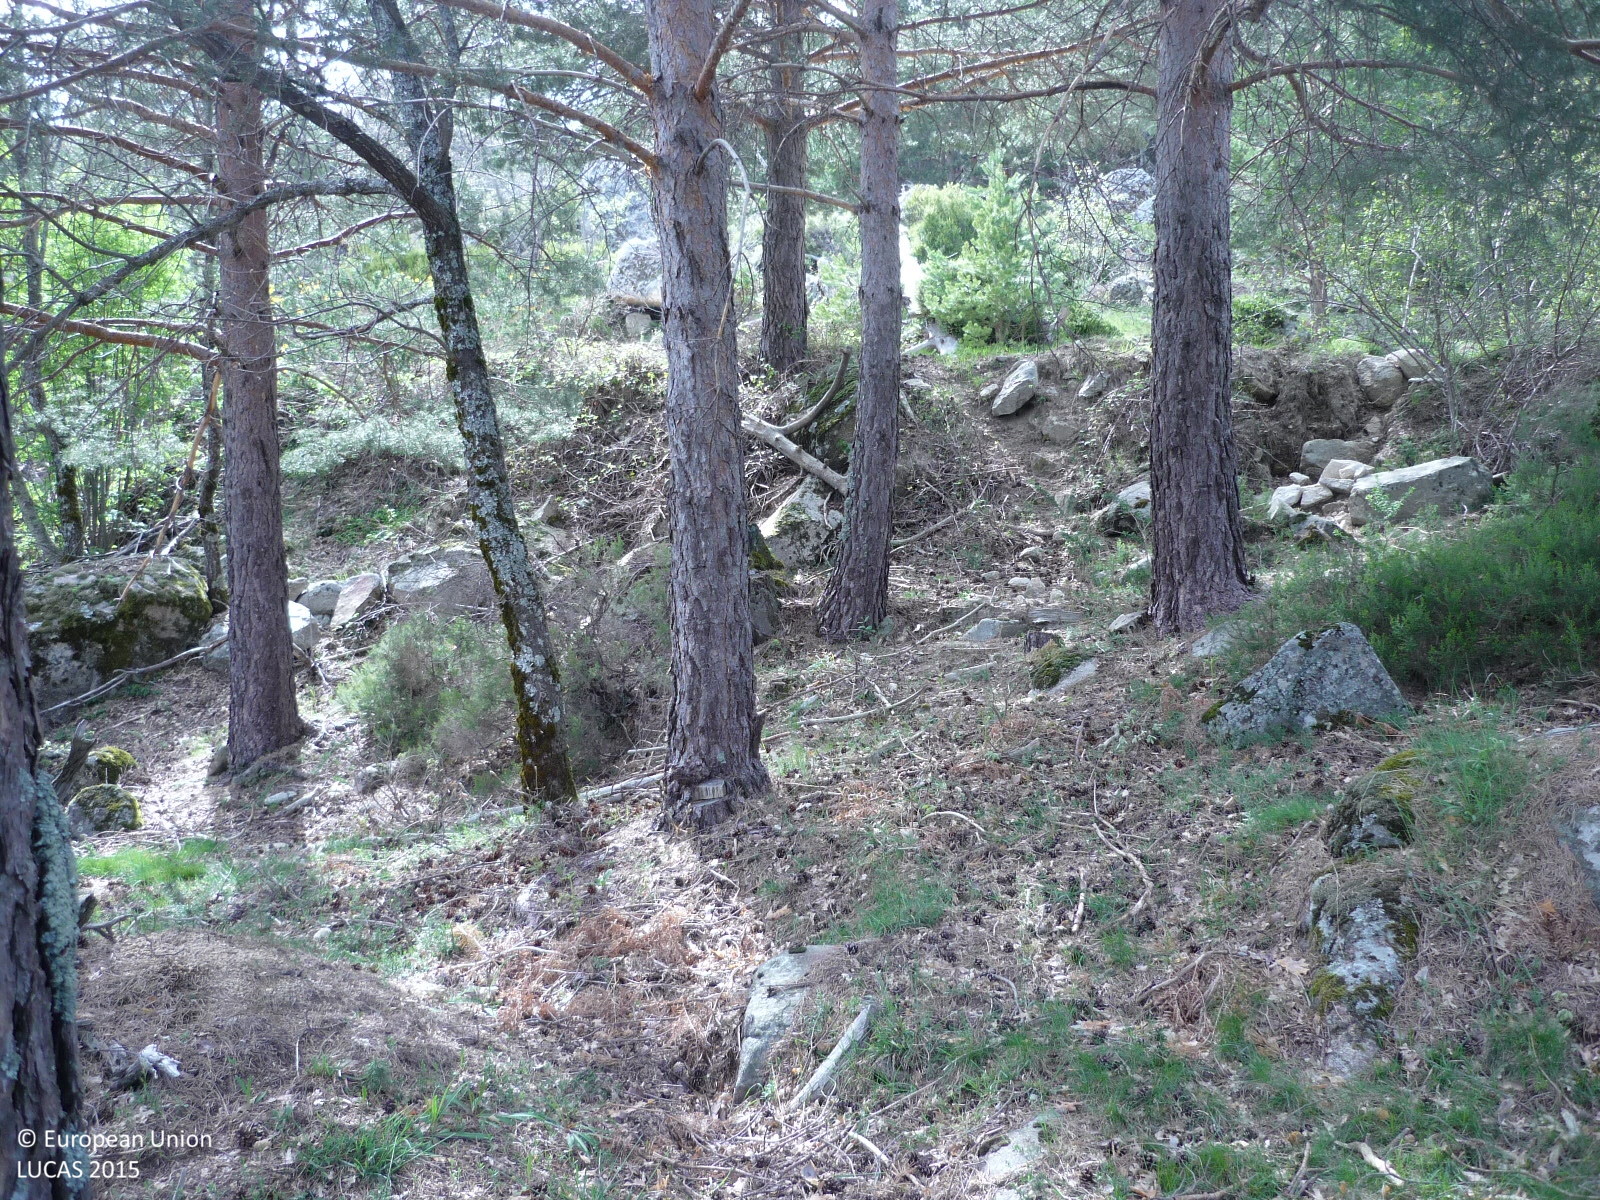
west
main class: Woodland
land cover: Pine dominated coniferous woodland
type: coniferous forest of the mediterranean region
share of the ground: > 75 %
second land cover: Grassland without tree/shrub cover
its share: 25 - 50 %
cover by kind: coniferous forest trees 85 %, shrubs 10 %, herbaceous plants 5 %
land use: Forestry
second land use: Agriculture (excluding fallow land and kitchen gardens)
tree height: > 5 m
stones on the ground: < 10 %
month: May
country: ES
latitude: 40.8821
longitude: -3.9195
